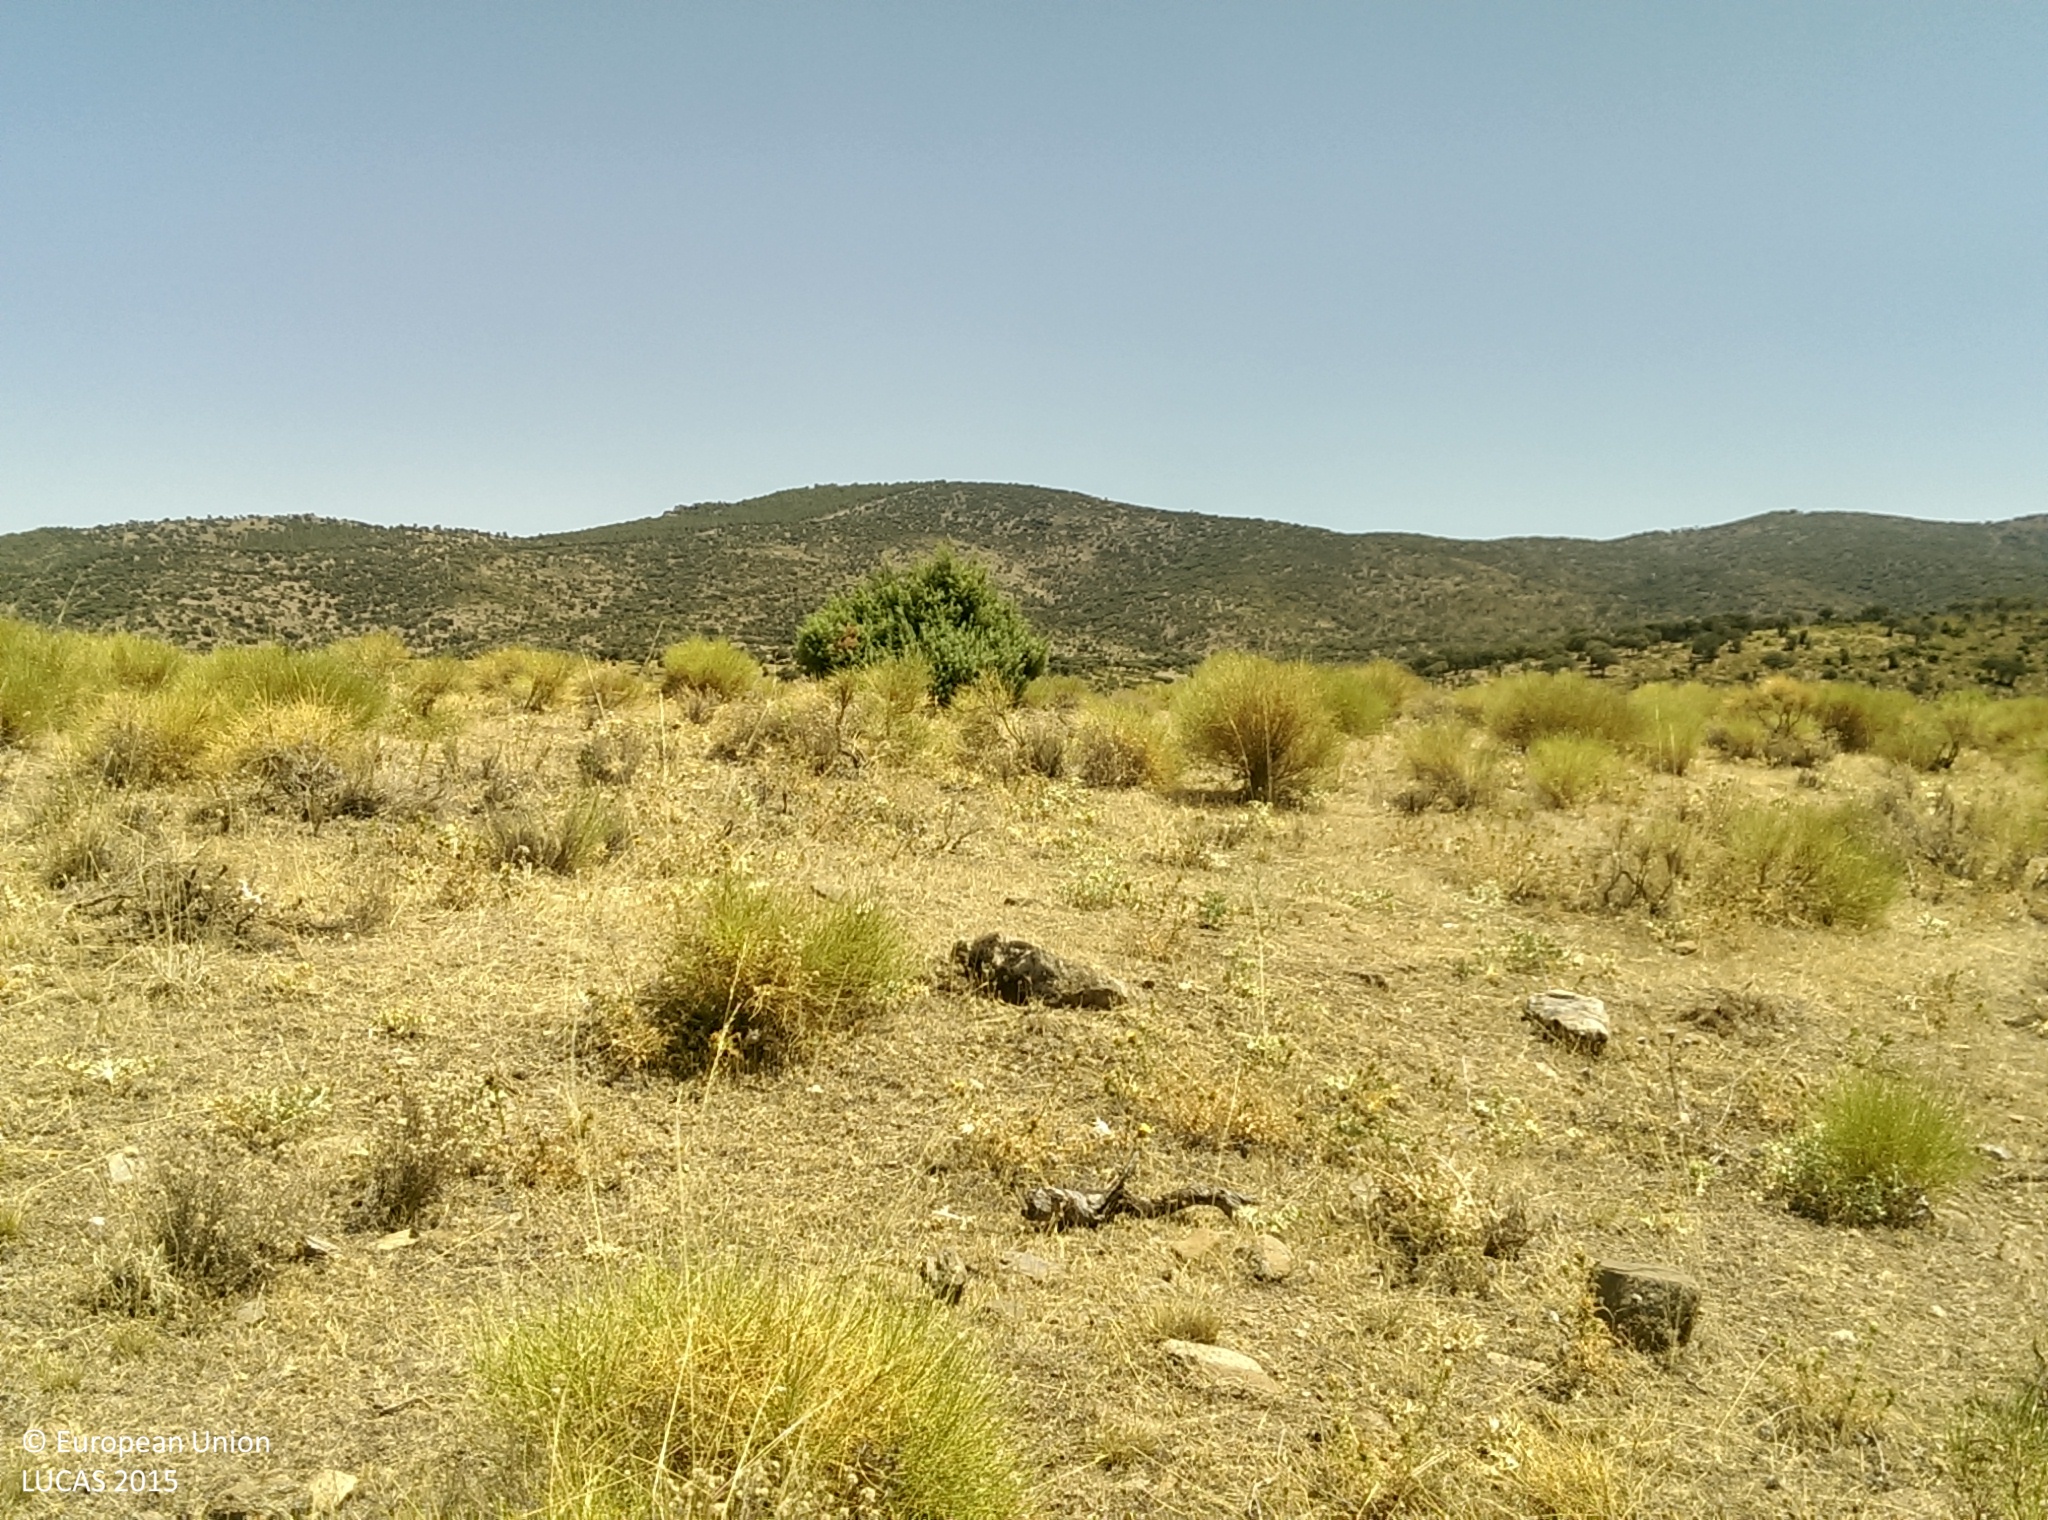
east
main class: Shrubland
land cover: Shrubland without tree cover
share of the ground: 25 - 50 %
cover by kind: shrubs 45 %, herbaceous plants 40 %, unconsolidated bare surface 15 %
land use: Agriculture (excluding fallow land and kitchen gardens)
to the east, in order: Shrubland without tree cover; Tracks; Shrubland without tree cover; Shrubland with sparse tree cover; Fences; Shrubland with sparse tree cover; Broadleaved woodland
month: July
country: ES
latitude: 37.2227
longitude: -3.2289
